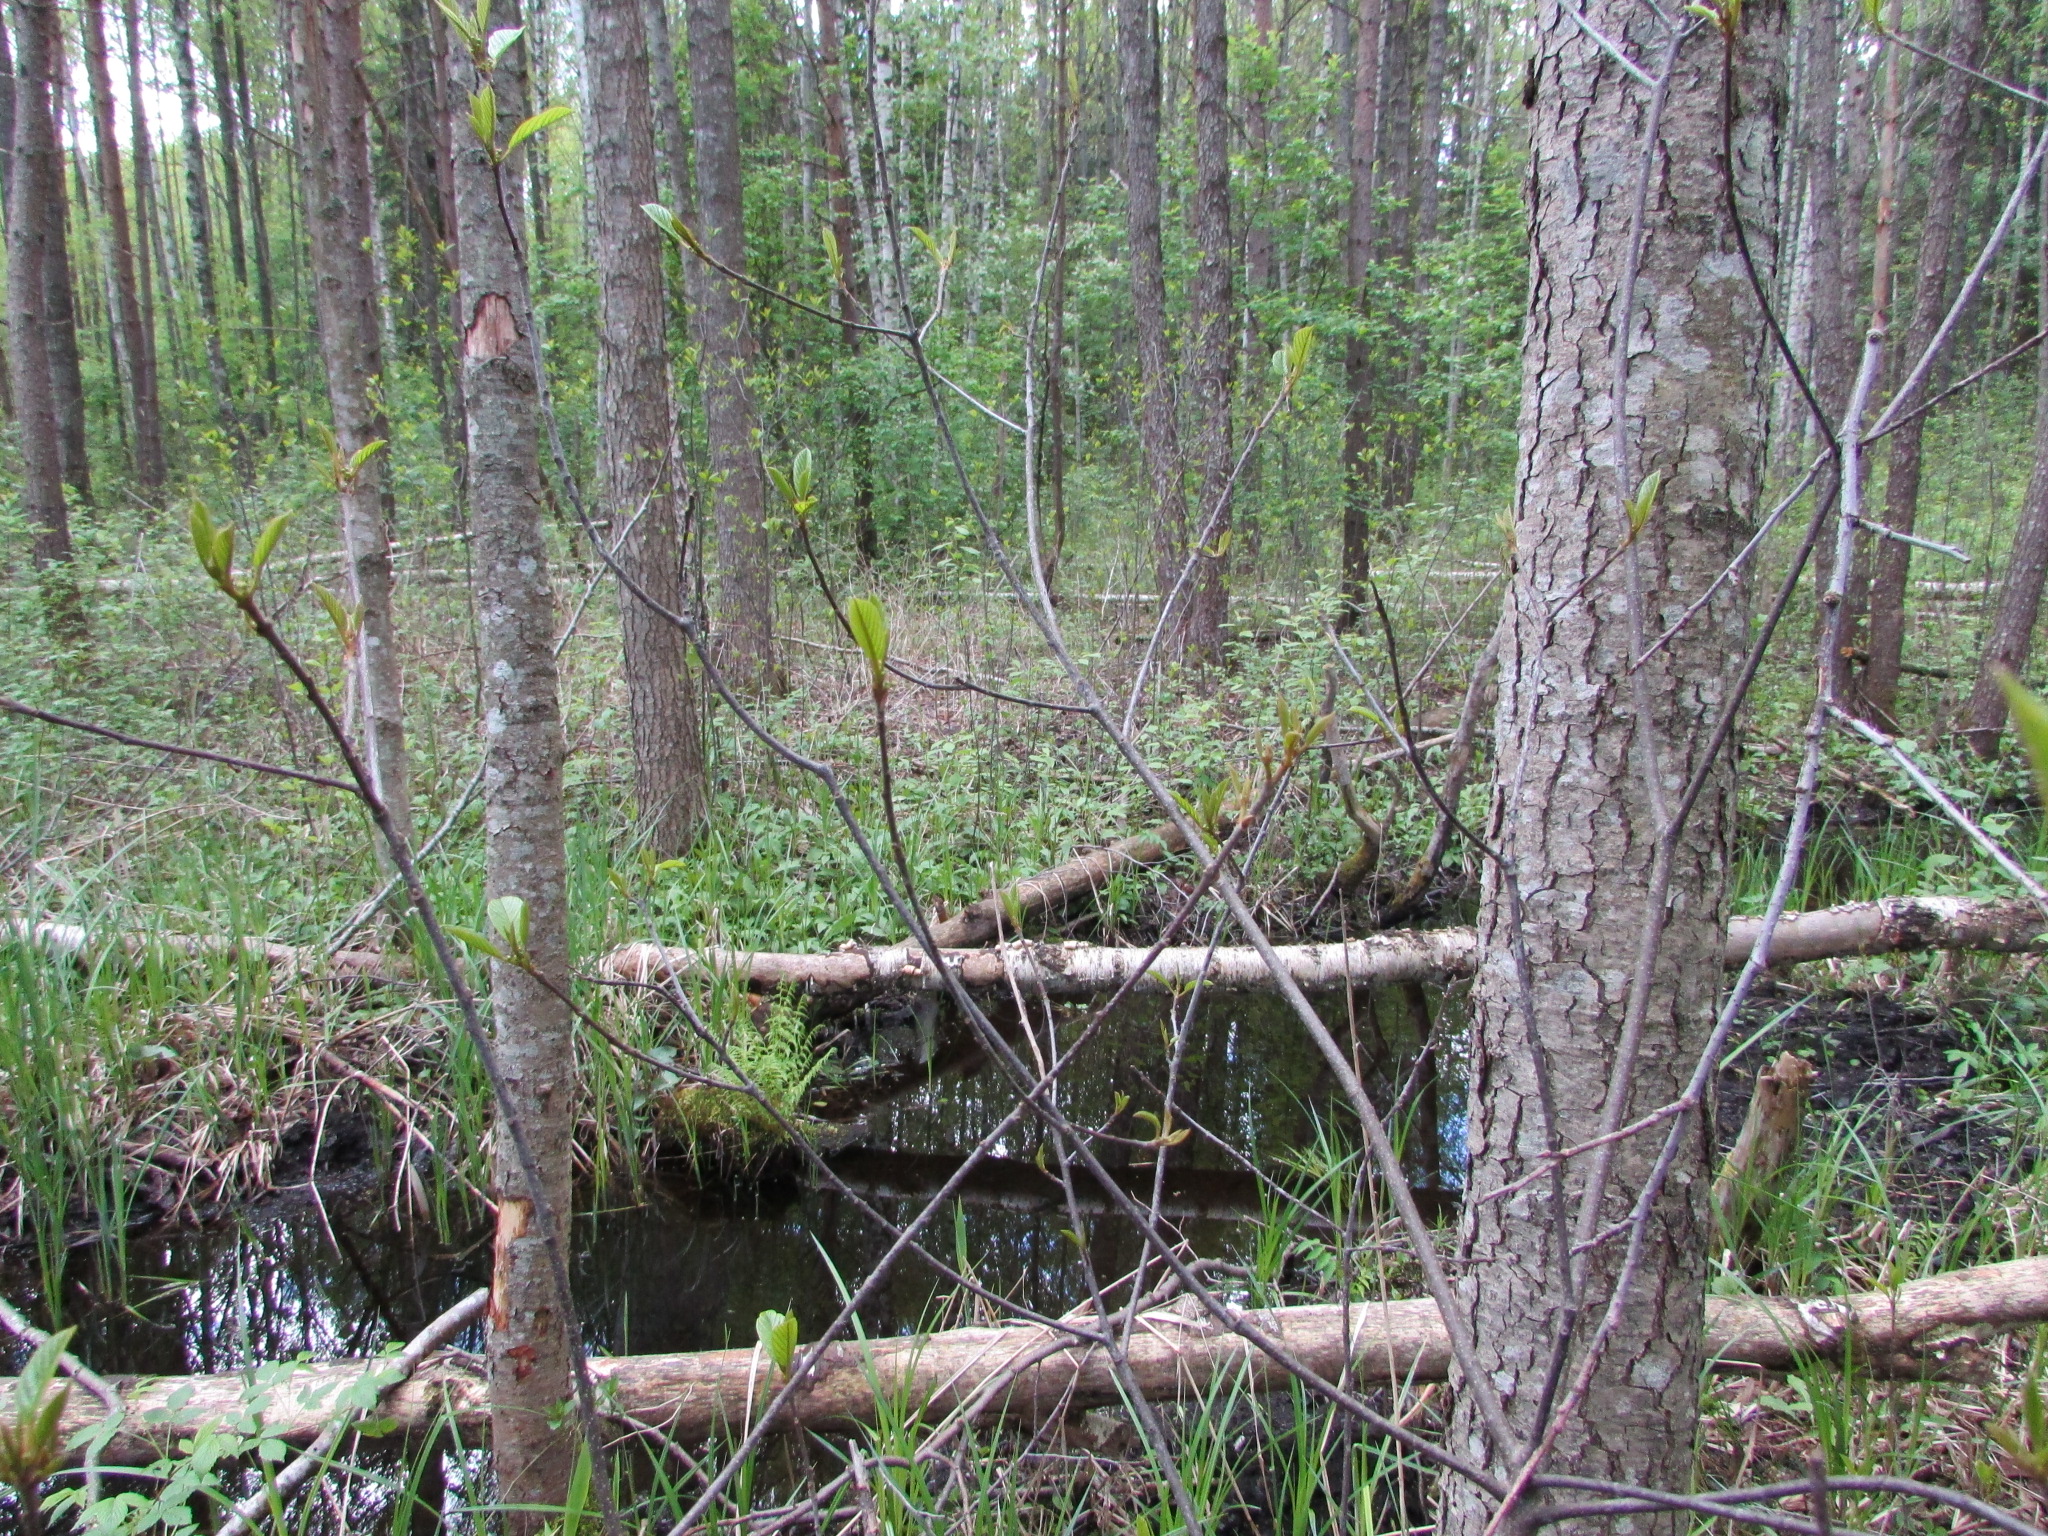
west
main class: Woodland
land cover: Pine dominated mixed woodland
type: hemiboreal forest and nemoral coniferous forest and mixed broadleaved-coniferous forest
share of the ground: > 75 %
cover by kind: coniferous forest trees 70 %, broadleaved forest trees 30 %
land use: Forestry
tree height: > 5 m
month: May
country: LV
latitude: 56.1273
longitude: 27.2749
